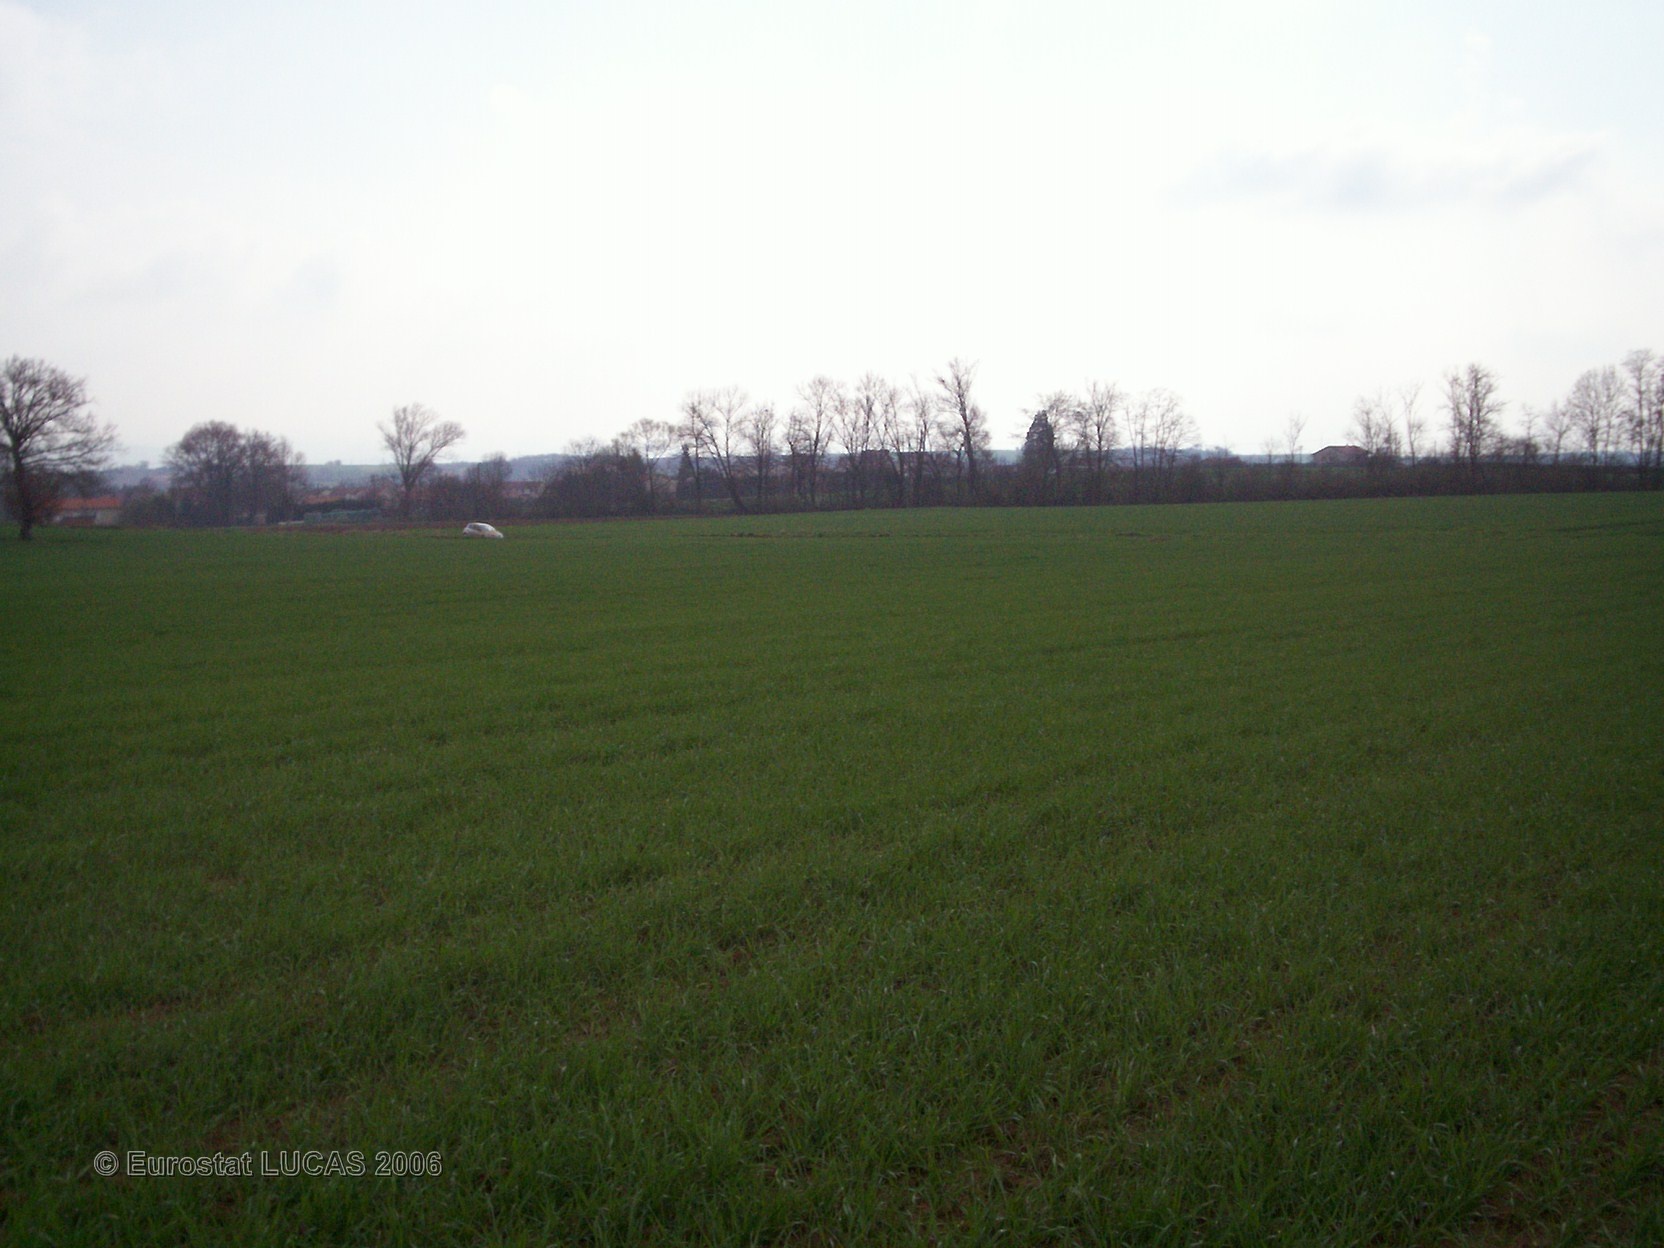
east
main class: Cropland
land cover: Common wheat
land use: Agriculture (excluding fallow land and kitchen gardens)
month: April
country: FR
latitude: 45.3638
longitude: 3.2991
